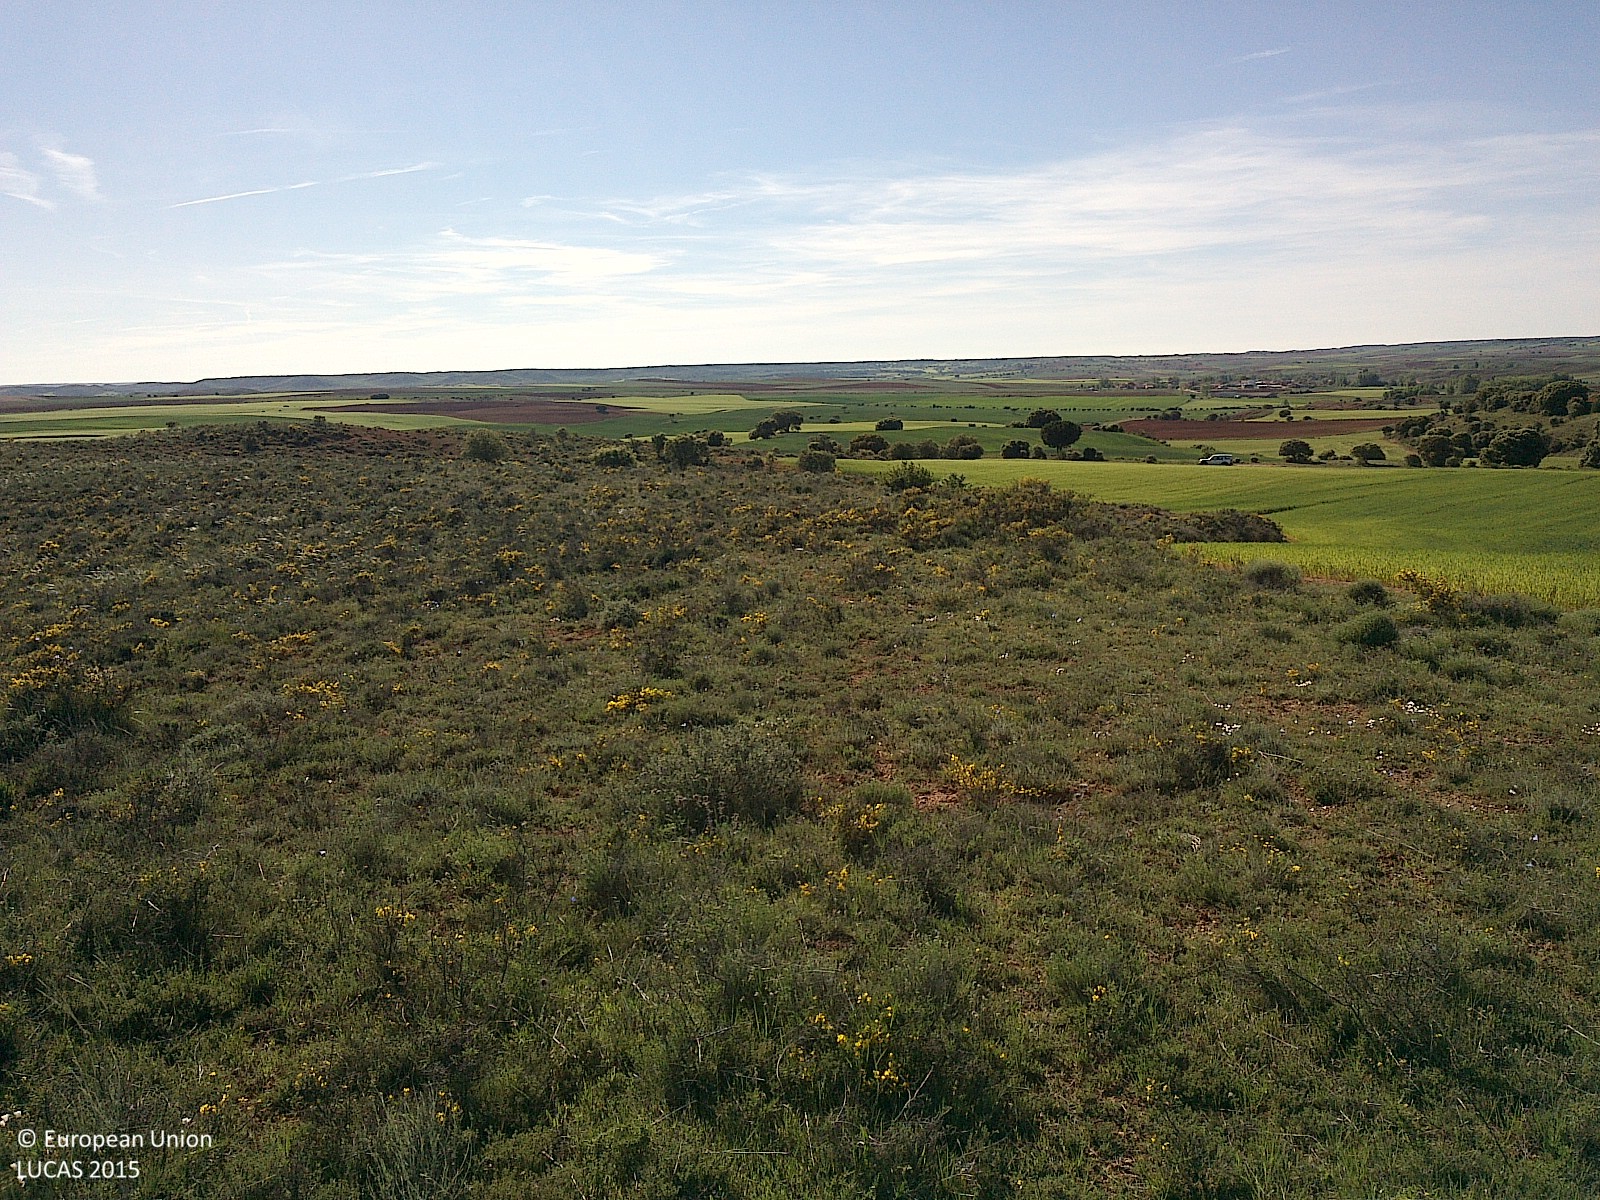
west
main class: Shrubland
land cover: Shrubland without tree cover
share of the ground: 50 - 75 %
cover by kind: shrubs 65 %, herbaceous plants 20 %, consolidated bare surface 15 %
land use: Semi-natural and natural areas not in use
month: May
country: ES
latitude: 41.6230
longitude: -3.1877
